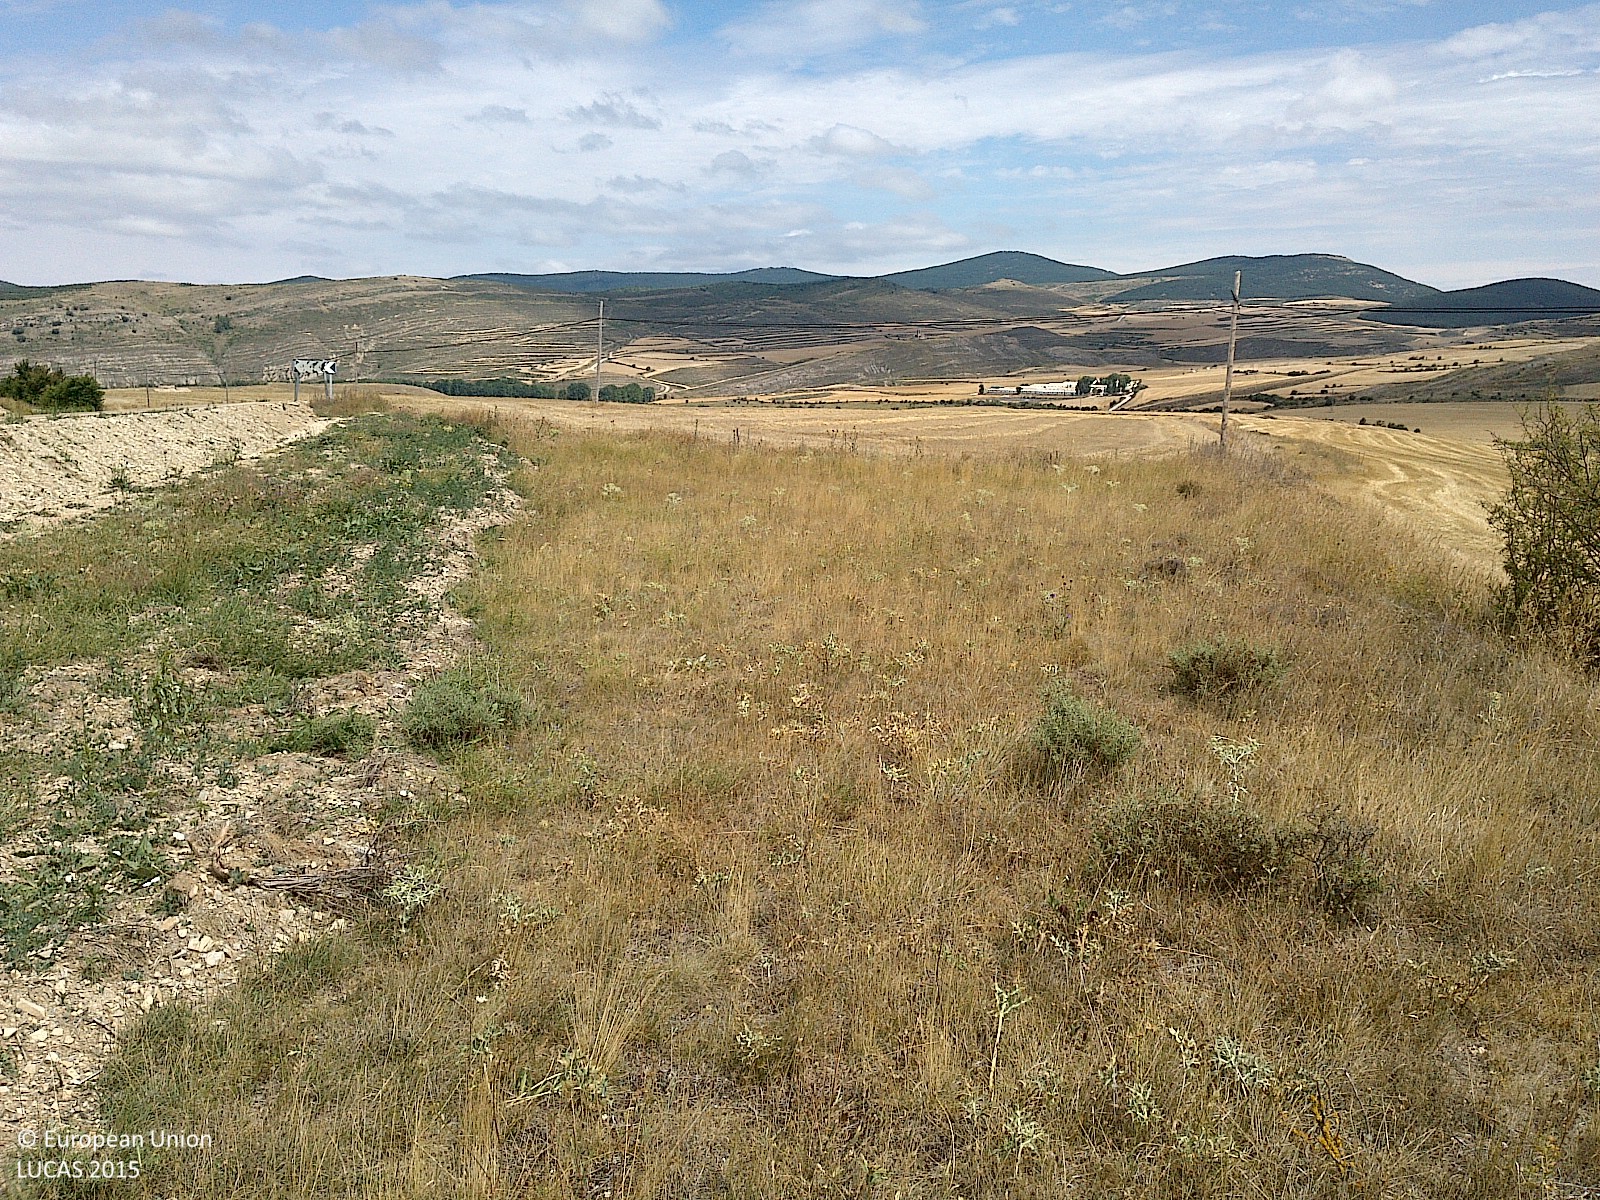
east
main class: Grassland
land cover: Grassland without tree/shrub cover
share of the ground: > 75 %
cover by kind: herbaceous plants 80 %, unconsolidated bare surface 15 %, shrubs 5 %
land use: Semi-natural and natural areas not in use
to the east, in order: Grassland without tree/shrub cover; Durum wheat; Electric lines; Durum wheat
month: July
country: ES
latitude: 42.0173
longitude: -2.2470
